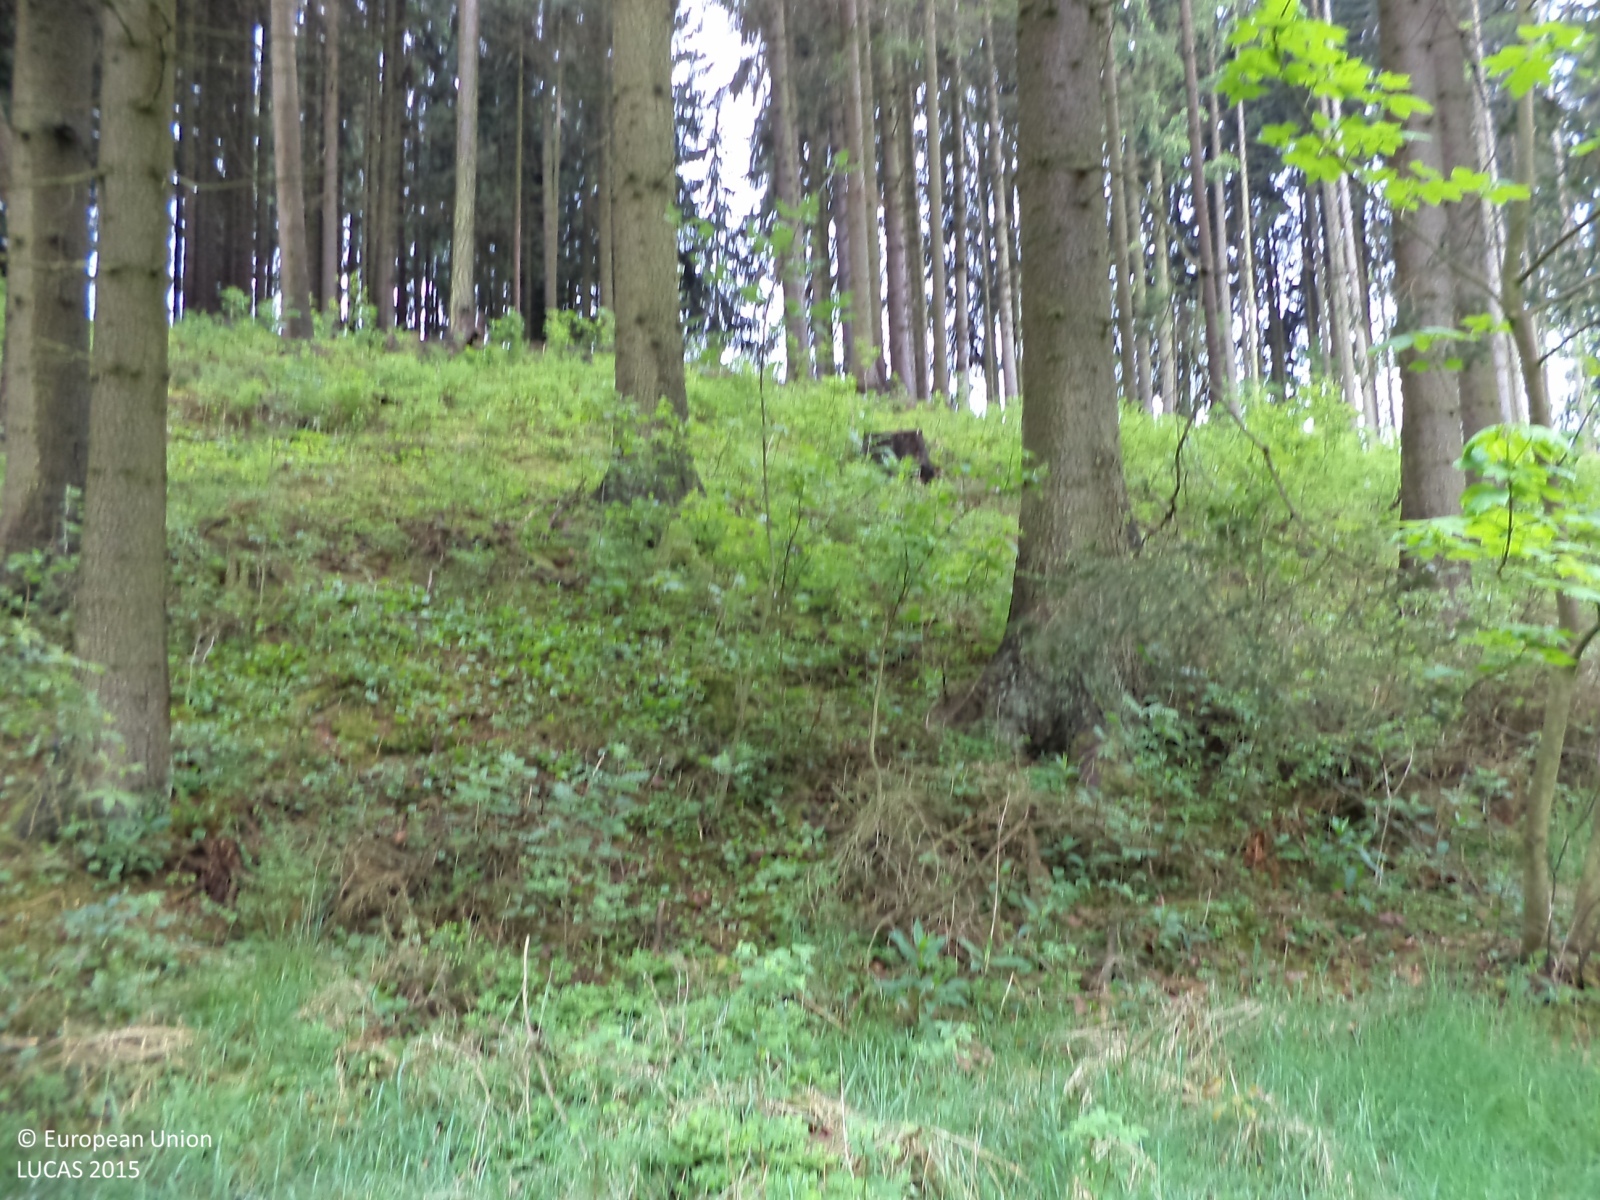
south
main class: Grassland
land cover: Grassland with sparse tree/shrub cover
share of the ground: > 75 %
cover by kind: herbaceous plants 90 %, broadleaved forest trees 5 %, shrubs 5 %
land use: Forestry
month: May
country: CZ
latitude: 49.4831
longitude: 14.9300
